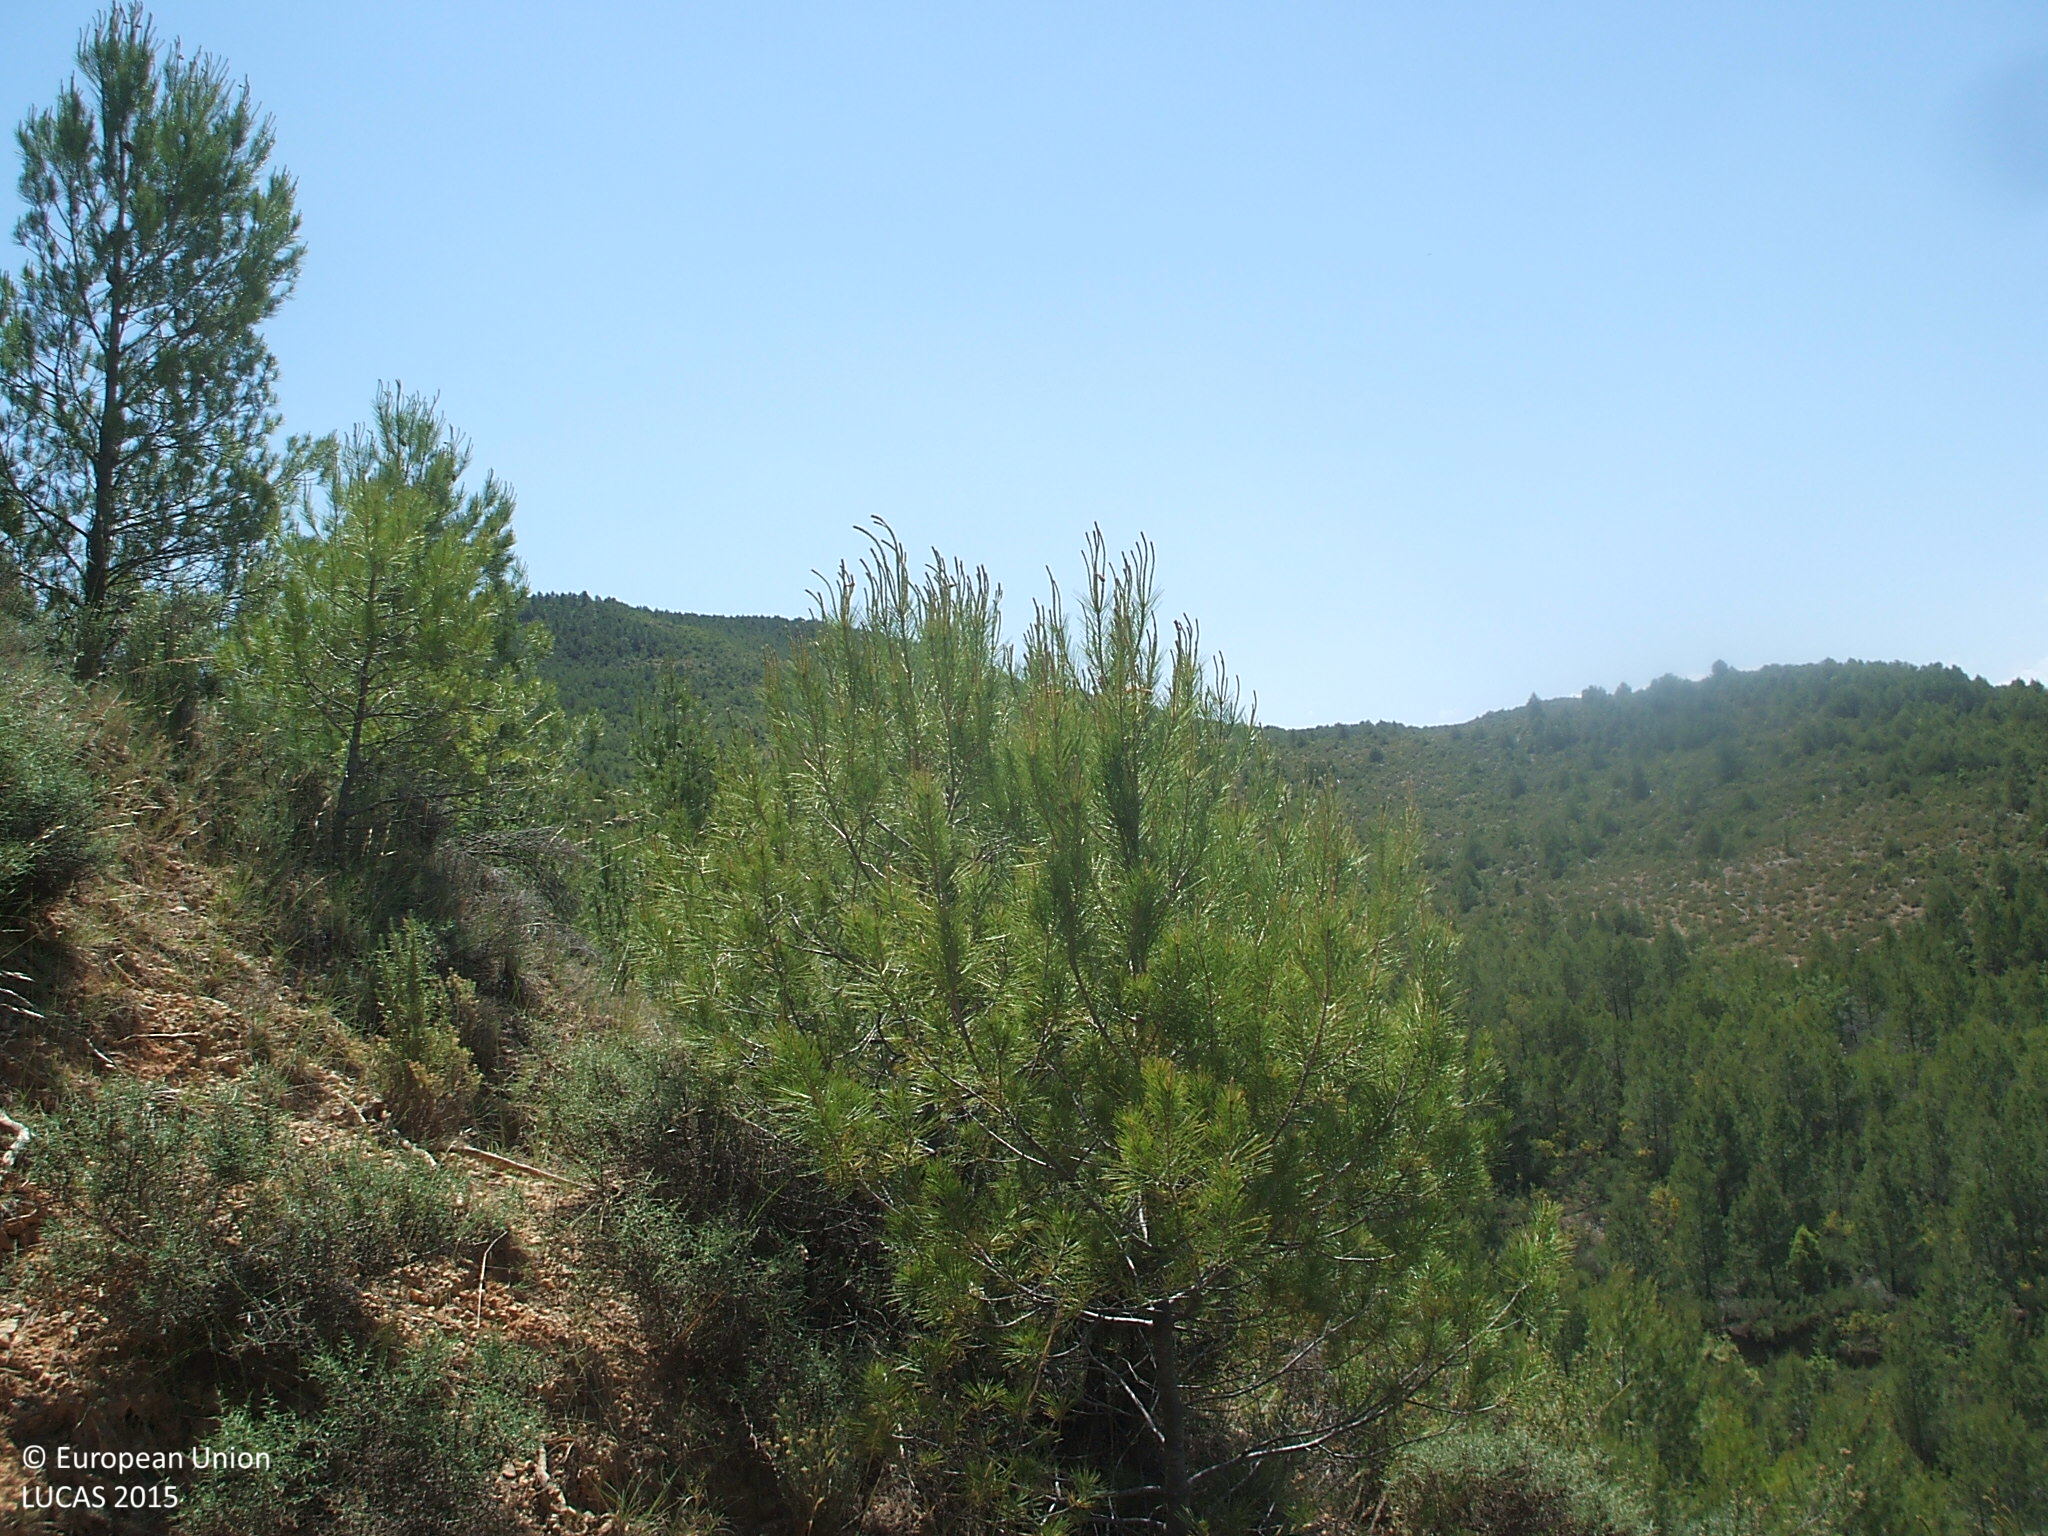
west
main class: Woodland
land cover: Pine dominated coniferous woodland
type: coniferous forest of the mediterranean region
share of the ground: 25 - 50 %
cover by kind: shrubs 50 %, coniferous forest trees 40 %, consolidated bare surface 10 %
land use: Semi-natural and natural areas not in use
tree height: > 5 m
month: May
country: ES
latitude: 40.7049
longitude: -0.1517
